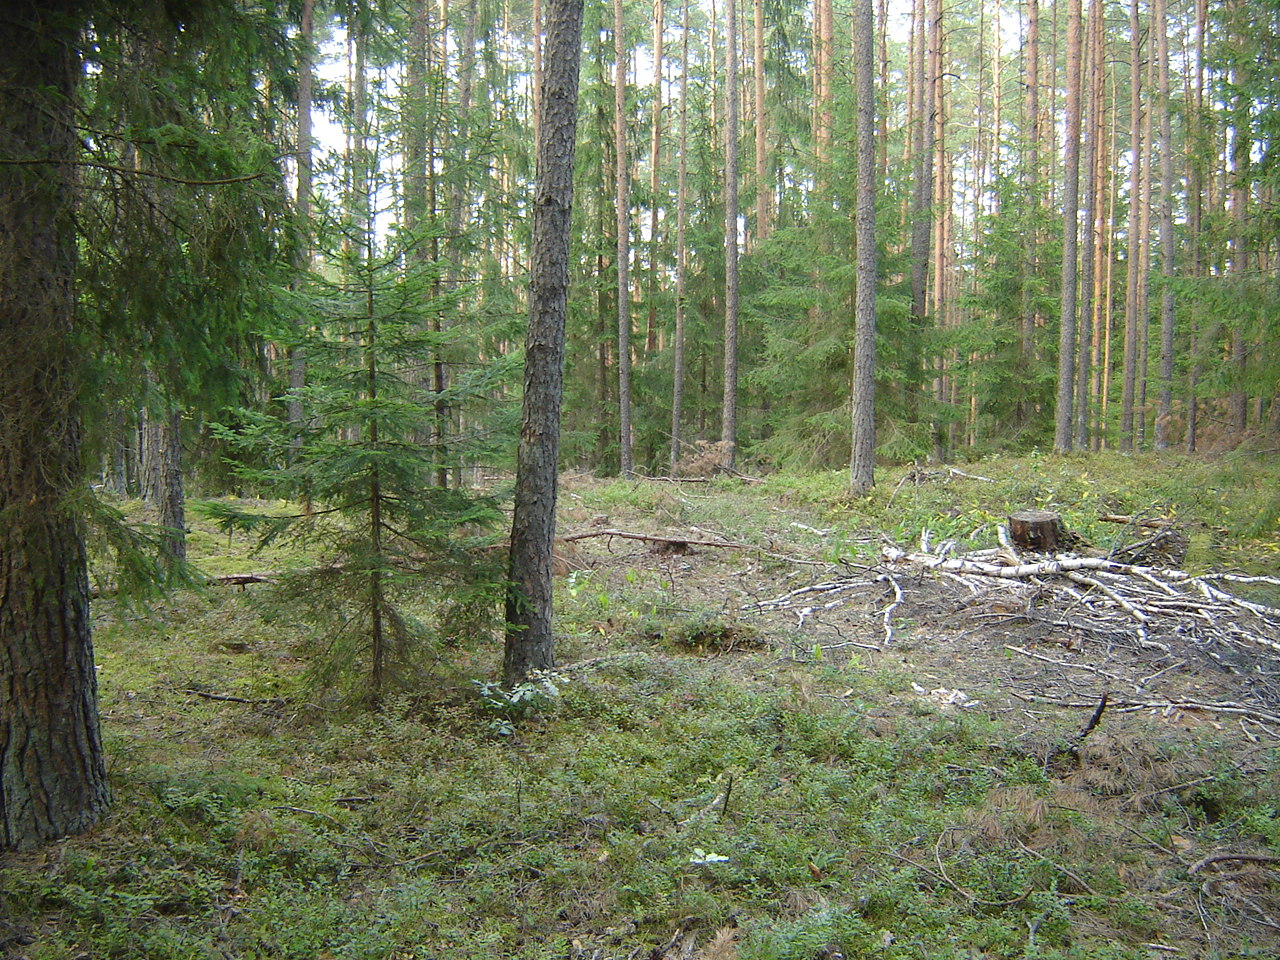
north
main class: Woodland
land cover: Pine dominated coniferous woodland
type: hemiboreal forest and nemoral coniferous forest and mixed broadleaved-coniferous forest
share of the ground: > 75 %
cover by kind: coniferous forest trees 80 %, shrubs 10 %, lichens and mosses 10 %
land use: Forestry
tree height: > 5 m
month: August
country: LT
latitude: 54.7835
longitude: 24.8672
